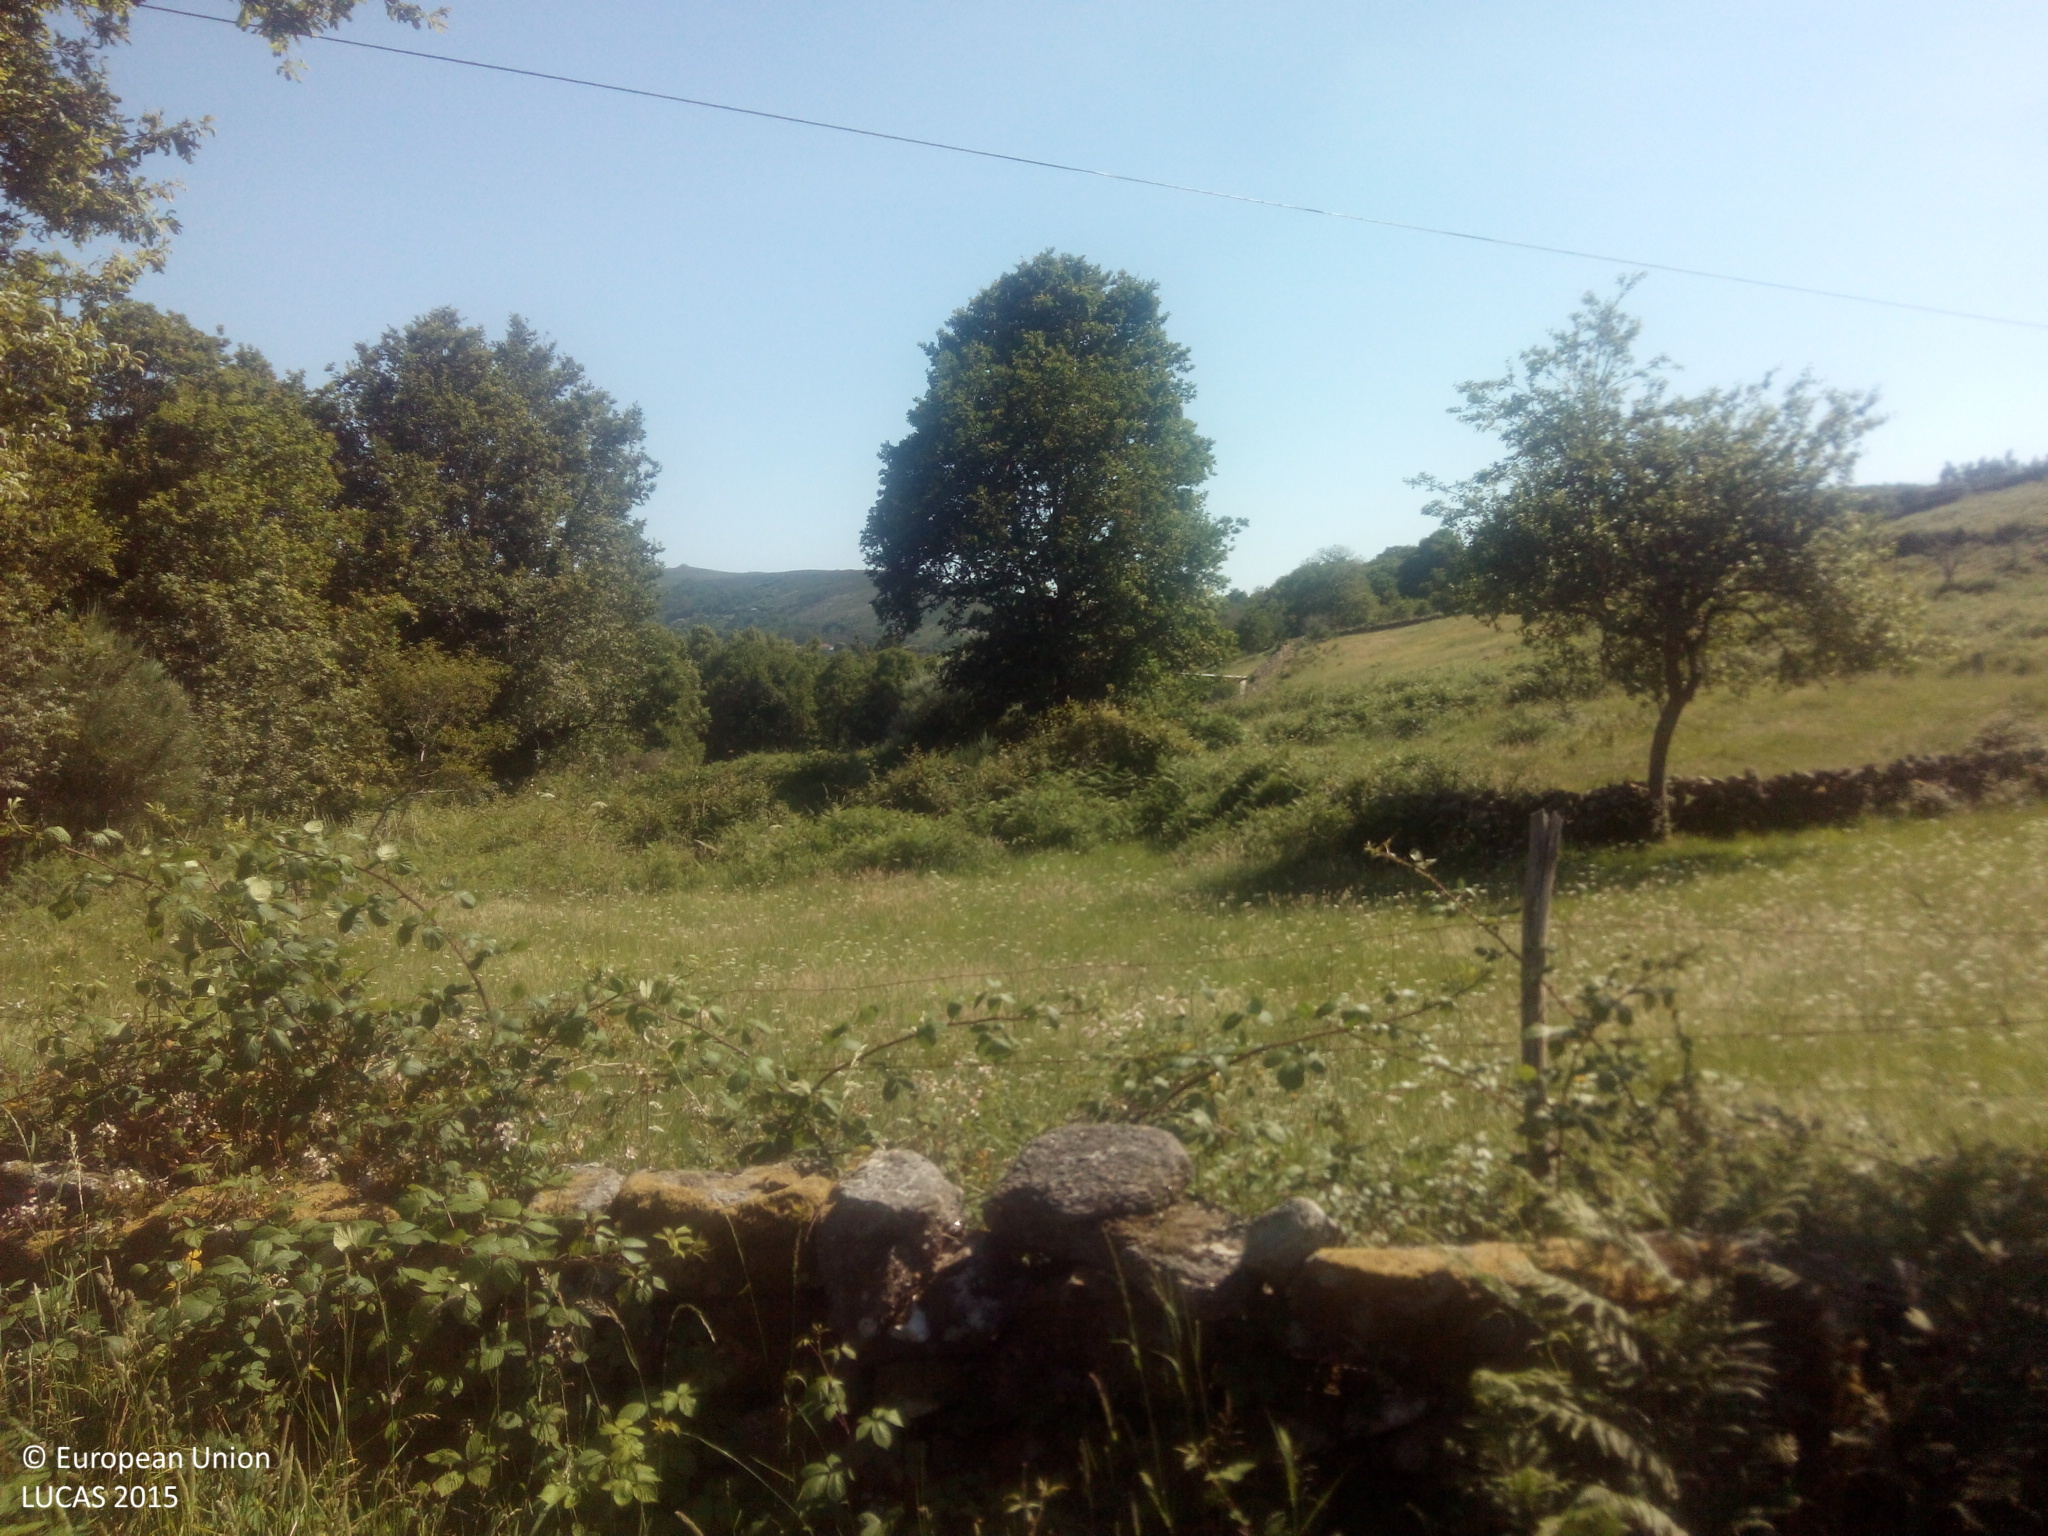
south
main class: Grassland
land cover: Grassland without tree/shrub cover
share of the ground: > 75 %
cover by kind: herbaceous plants 100 %
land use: Agriculture (excluding fallow land and kitchen gardens)
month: June
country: ES
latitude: 42.4313
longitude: -8.3874
